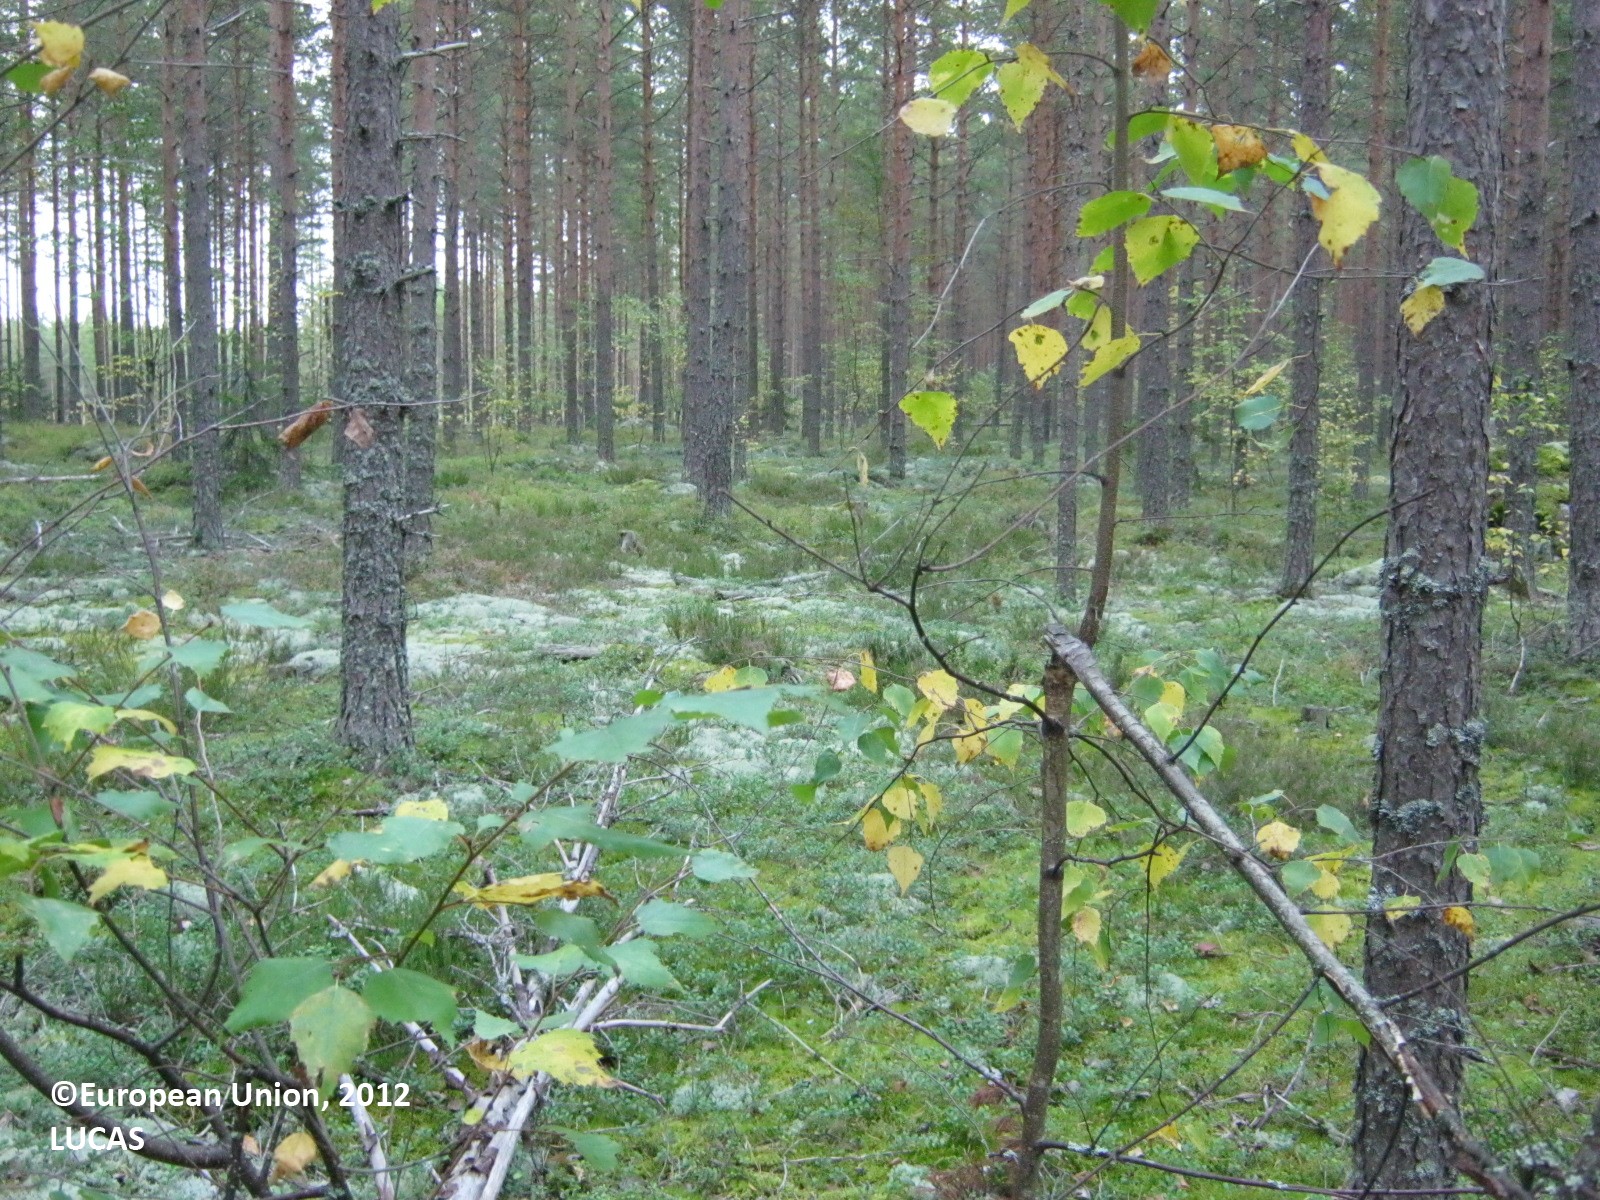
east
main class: Woodland
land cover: Other coniferous woodland
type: boreal forest
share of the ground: > 75 %
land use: Forestry
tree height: > 5 m
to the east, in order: Other coniferous woodland; Shrubland with sparse tree cover; Other coniferous woodland; Tracks; Other coniferous woodland
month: September
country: FI
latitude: 60.7365
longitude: 27.8192
